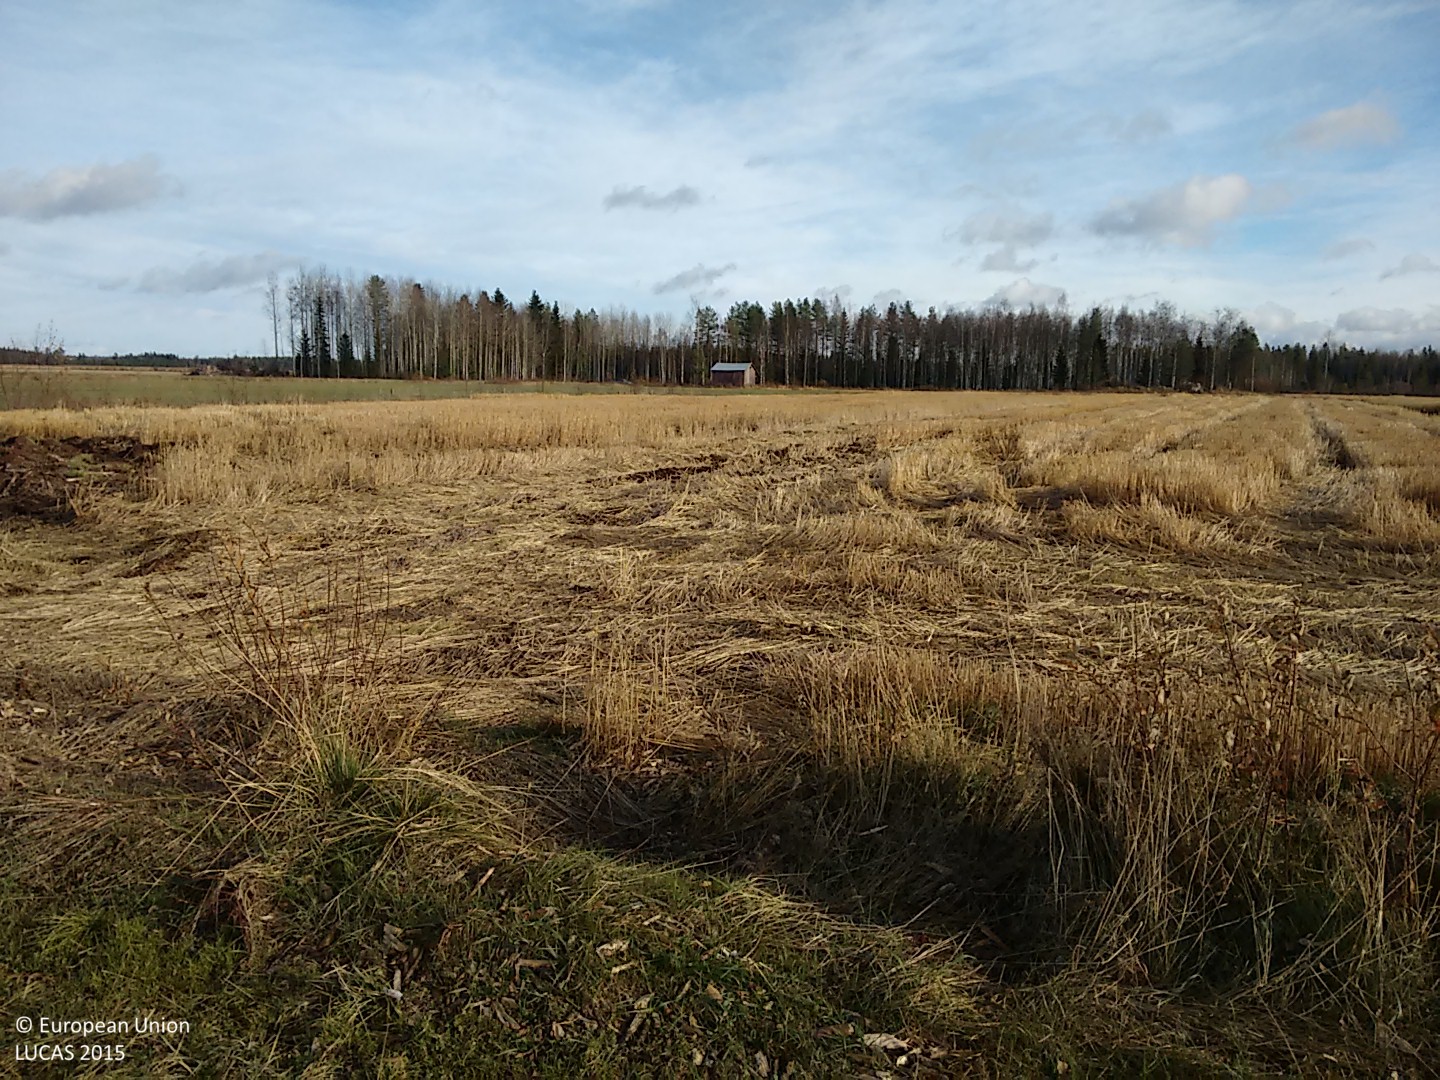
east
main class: Cropland
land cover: Oats
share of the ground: > 75 %
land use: Agriculture (excluding fallow land and kitchen gardens)
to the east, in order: Oats; Grass margins; Ditches and canals; Grass margins; Tracks; Oats; Shruby margins; Ditches and canals; Shruby margins; Temporary grasslands
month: October
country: FI
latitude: 63.9537
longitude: 25.2153
